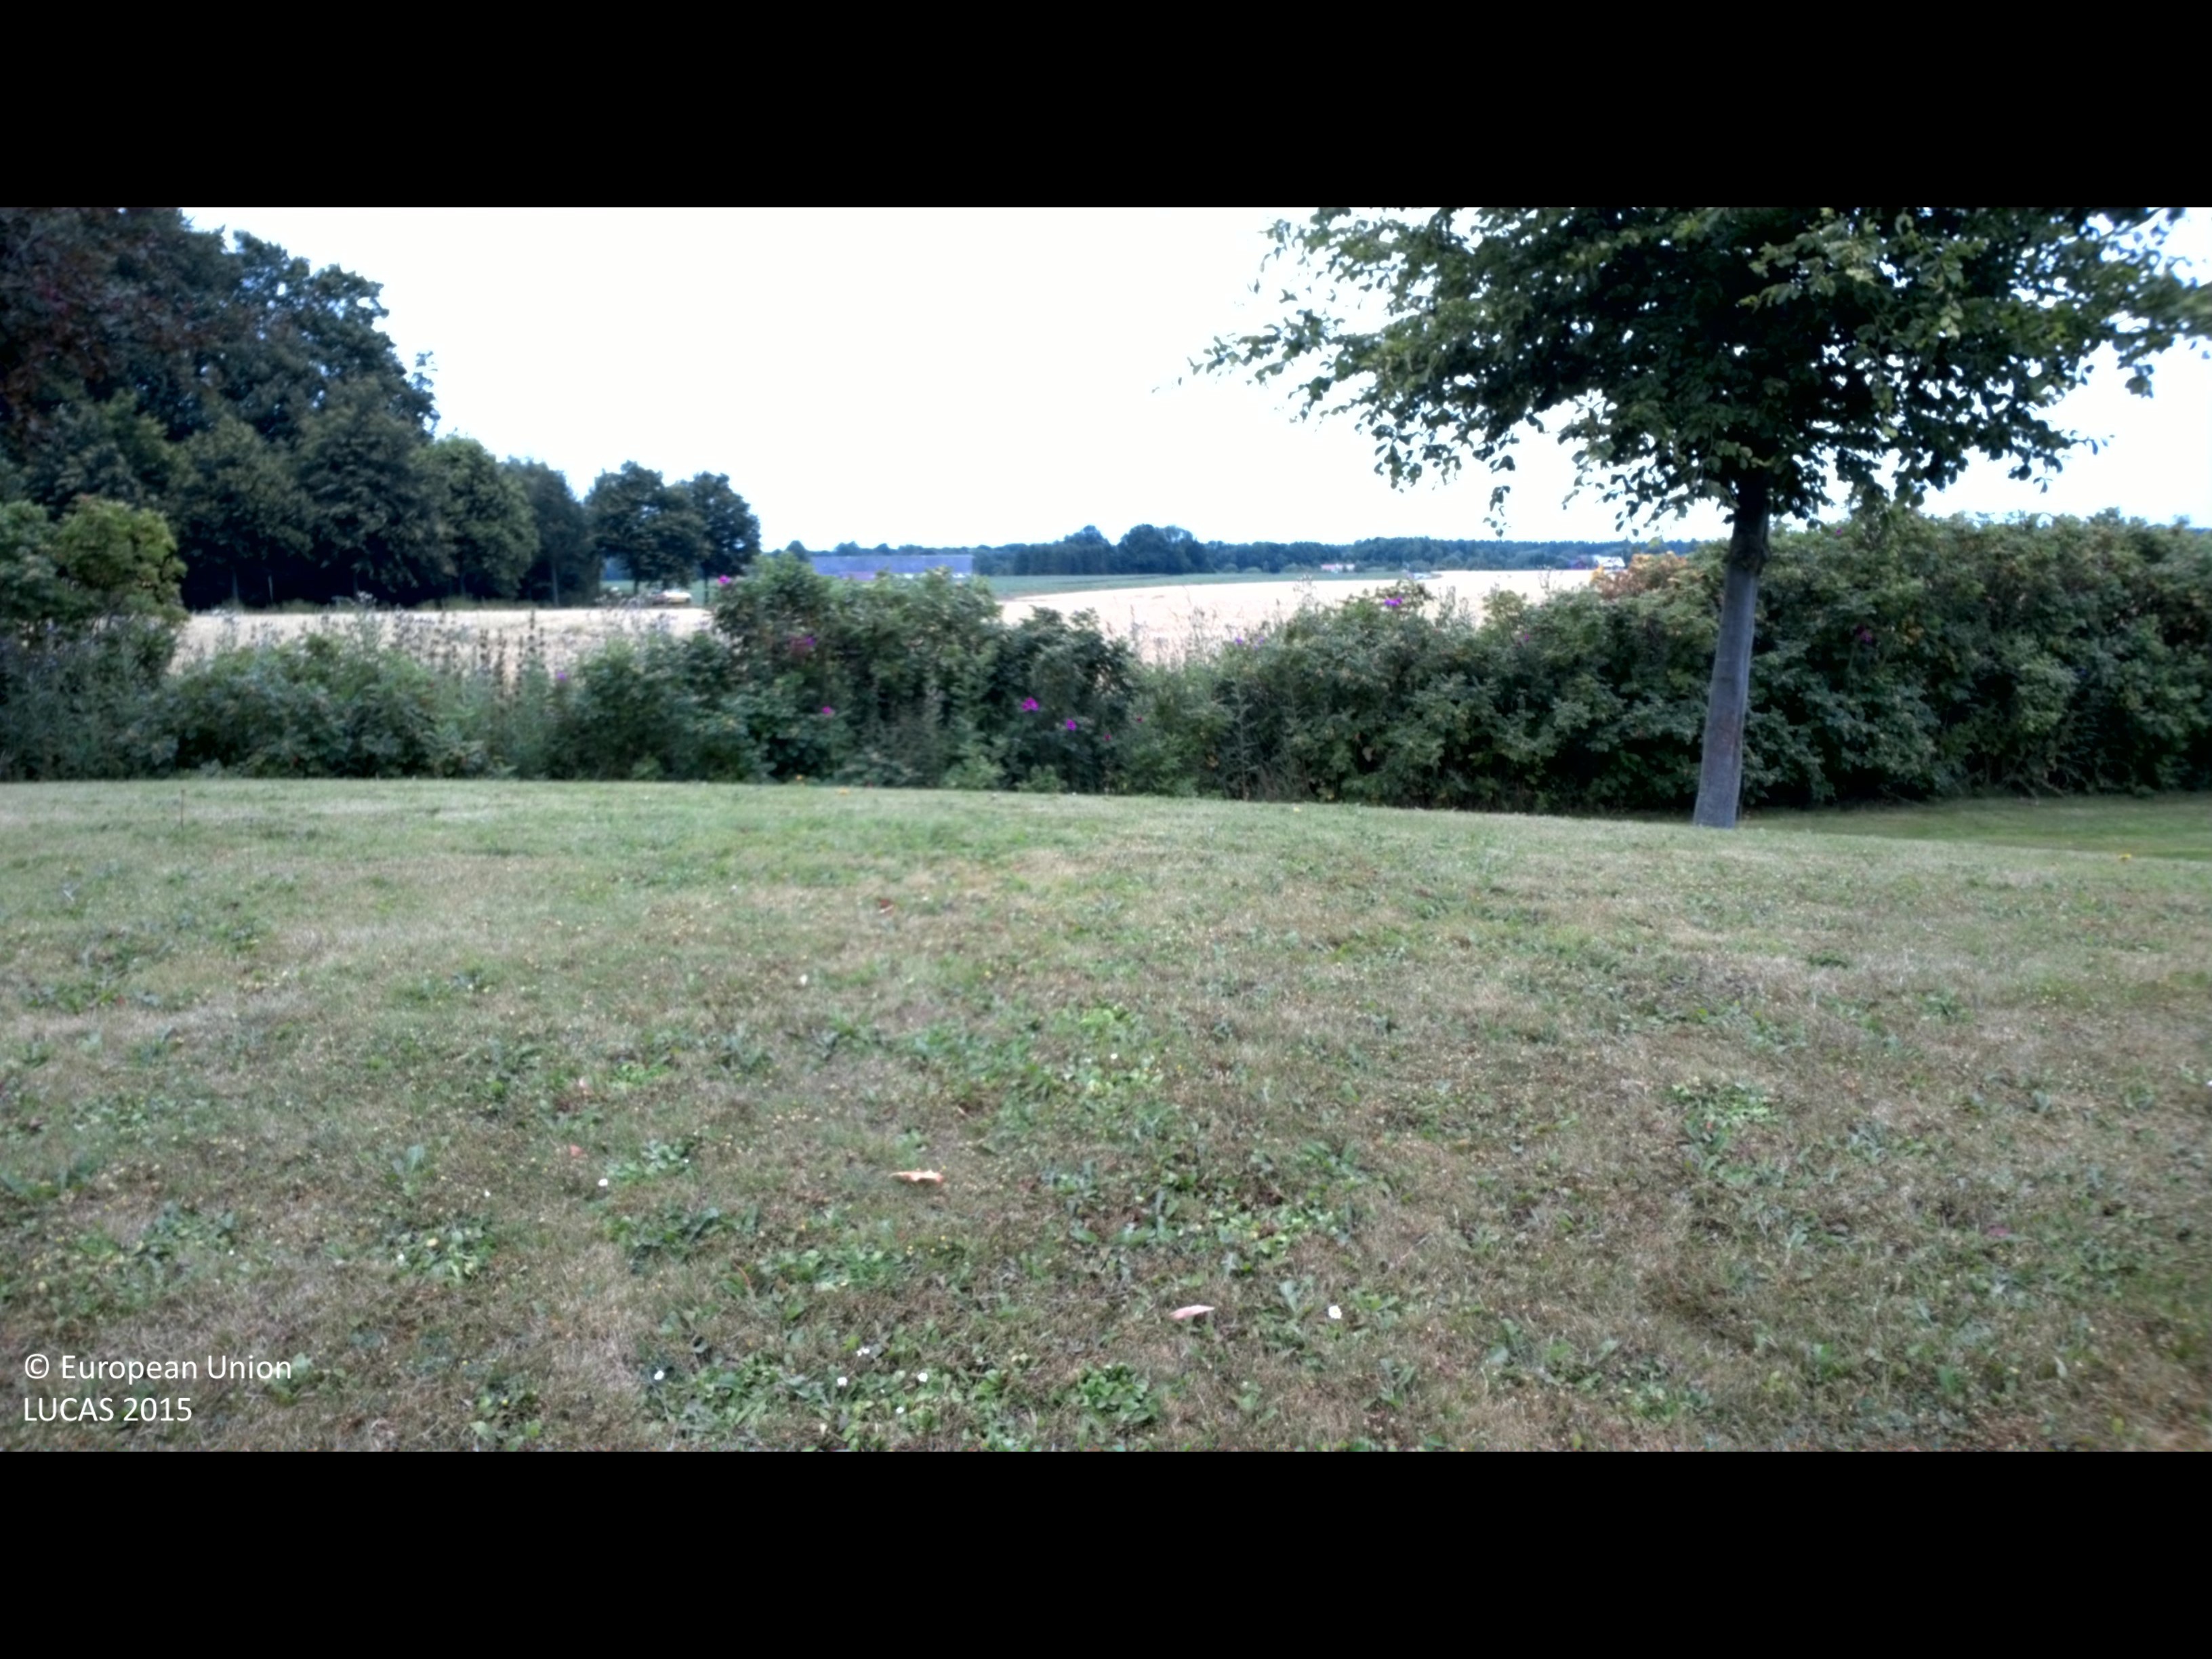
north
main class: Grassland
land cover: Grassland with sparse tree/shrub cover
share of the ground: > 75 %
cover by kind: herbaceous plants 95 %, broadleaved forest trees 5 %
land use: Community services
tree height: < 5 m
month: July
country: SE
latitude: 55.8891
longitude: 14.0752
